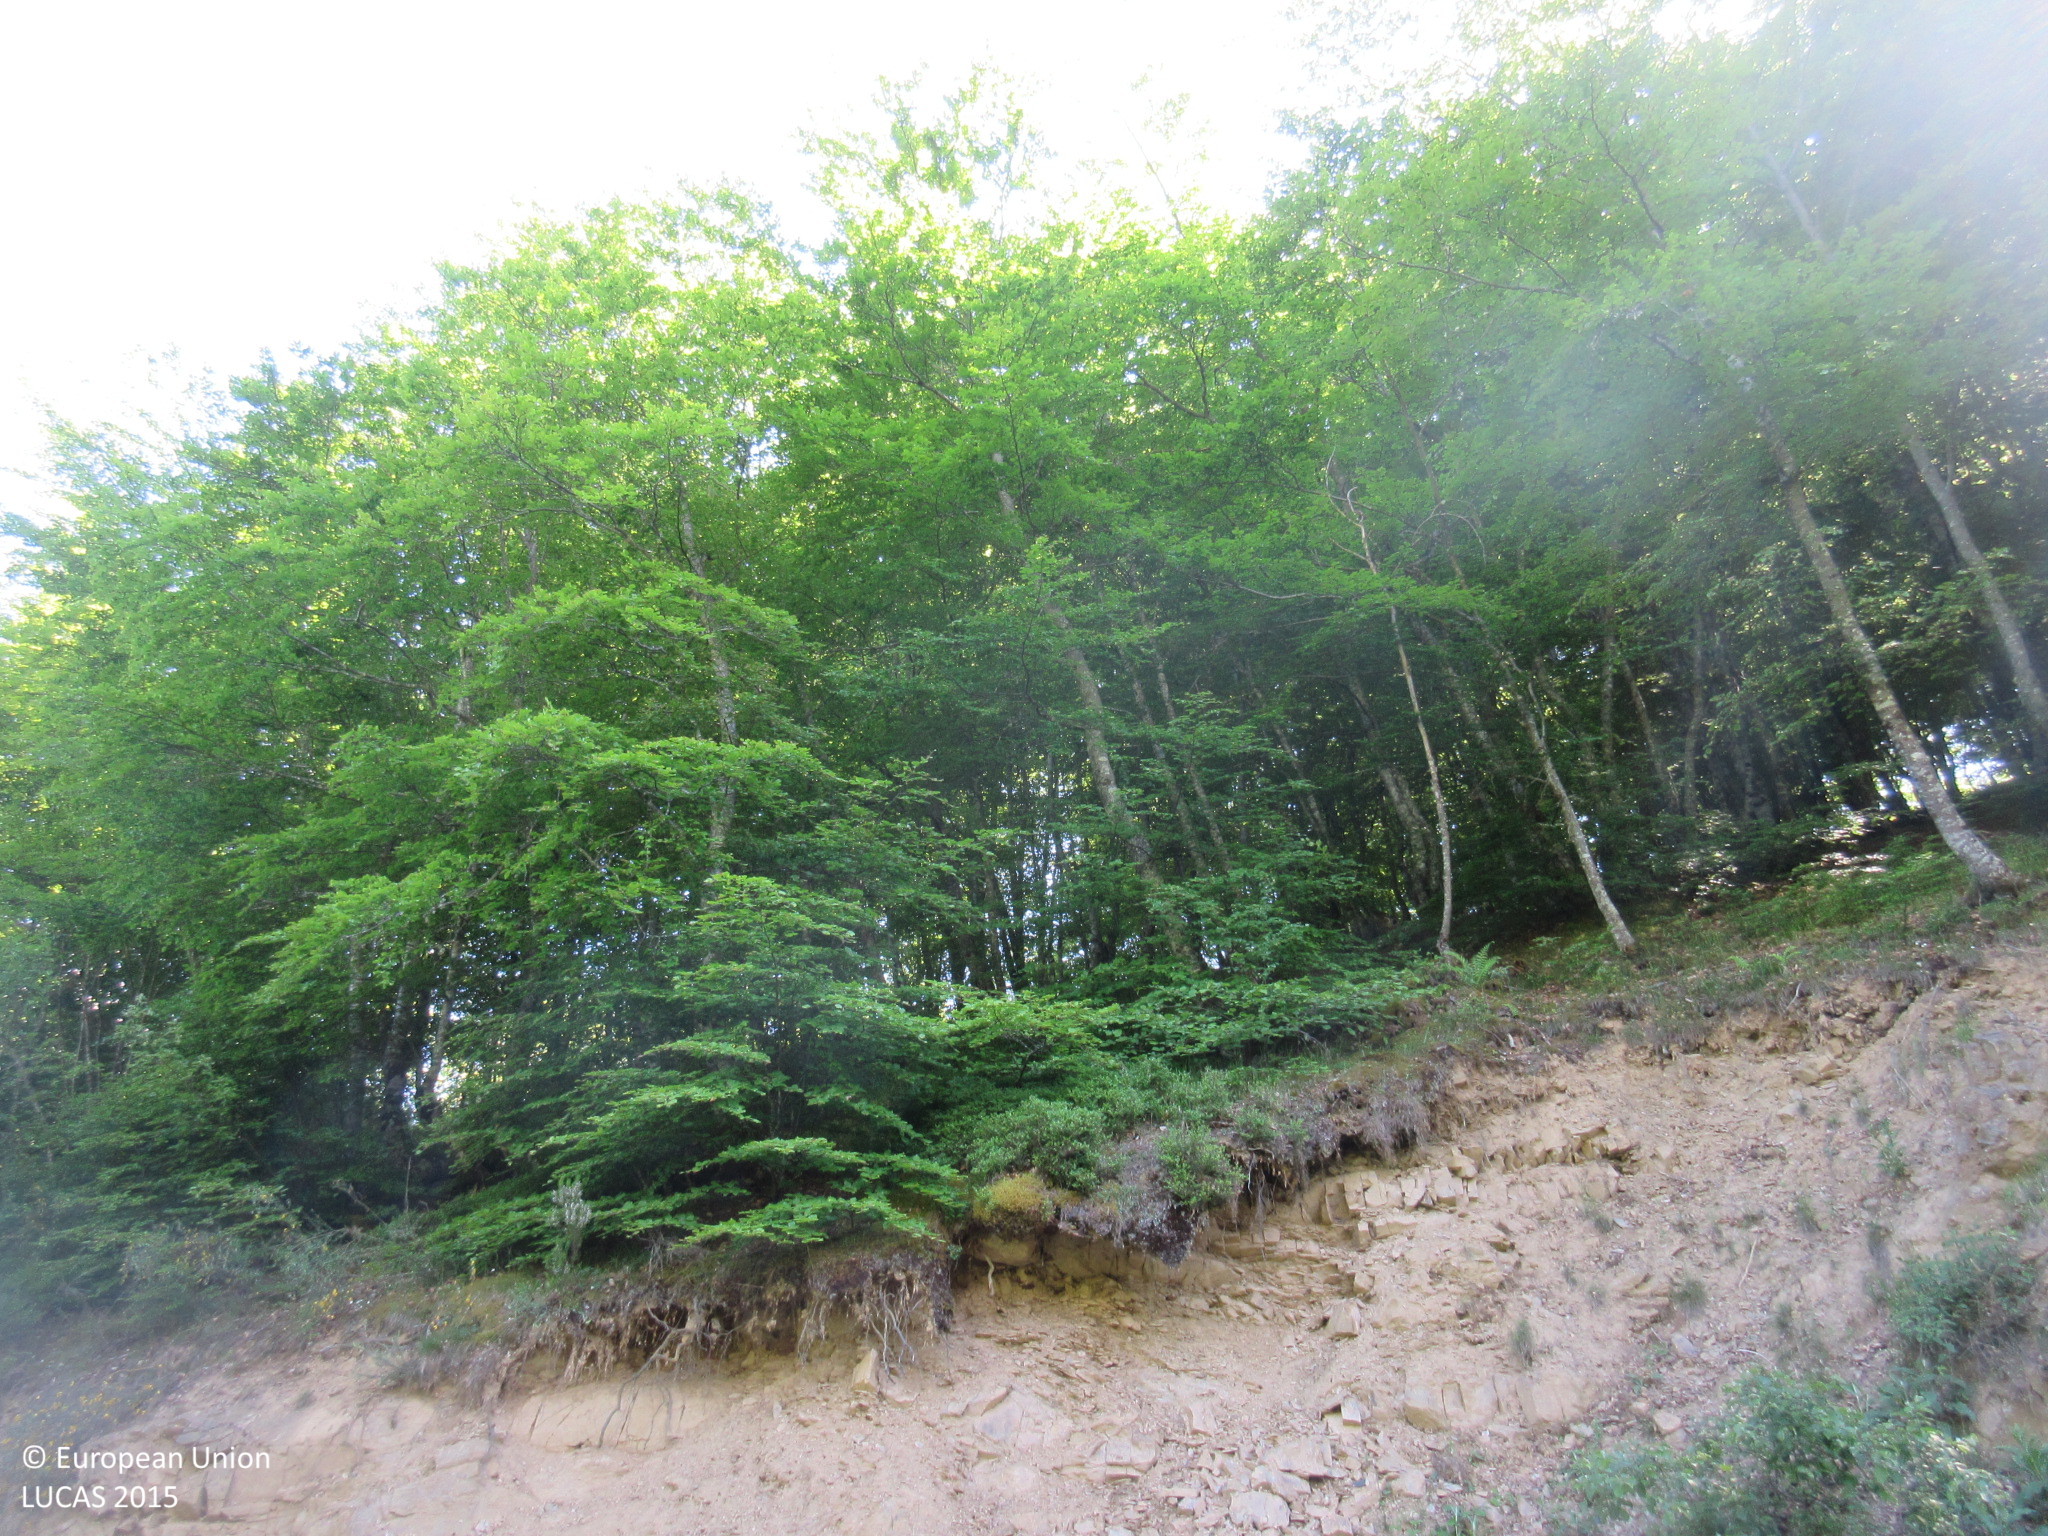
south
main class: Woodland
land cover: Broadleaved woodland
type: beech forest
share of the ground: > 75 %
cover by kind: broadleaved forest trees 100 %
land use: Semi-natural and natural areas not in use
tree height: > 5 m
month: June
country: ES
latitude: 43.1136
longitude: -4.4476
